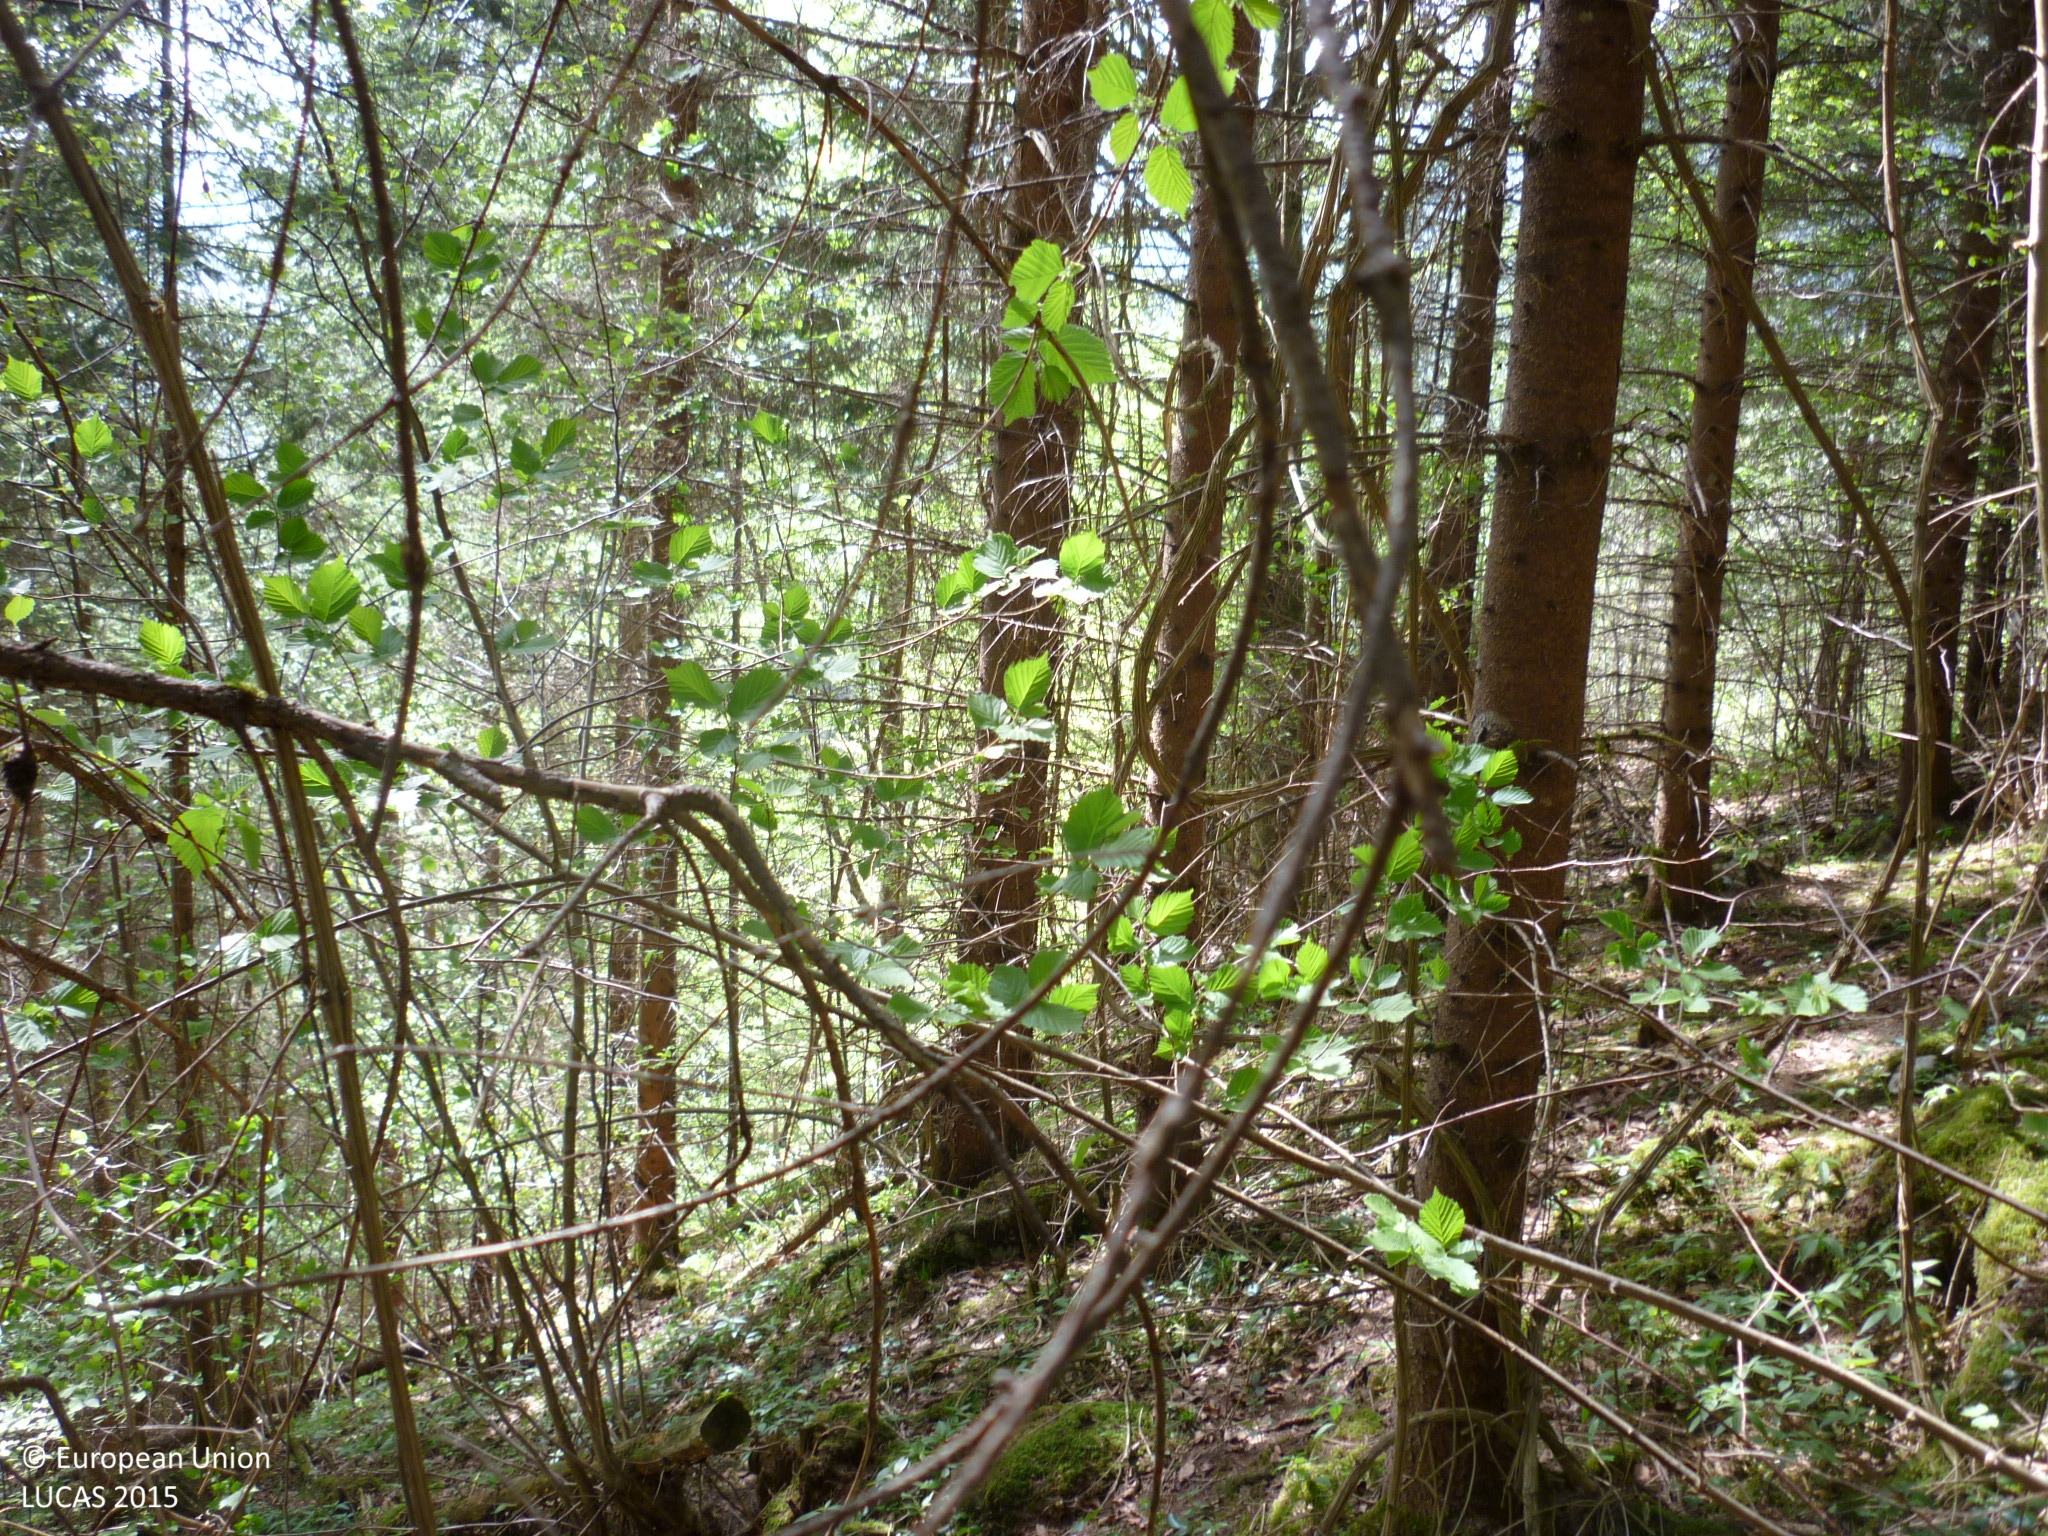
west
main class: Woodland
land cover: Spruce dominated coniferous woodland
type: alpine coniferous forest
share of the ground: > 75 %
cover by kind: coniferous forest trees 95 %, broadleaved forest trees 5 %
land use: Forestry
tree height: > 5 m
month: May
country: AT
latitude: 47.7039
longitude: 14.8109
